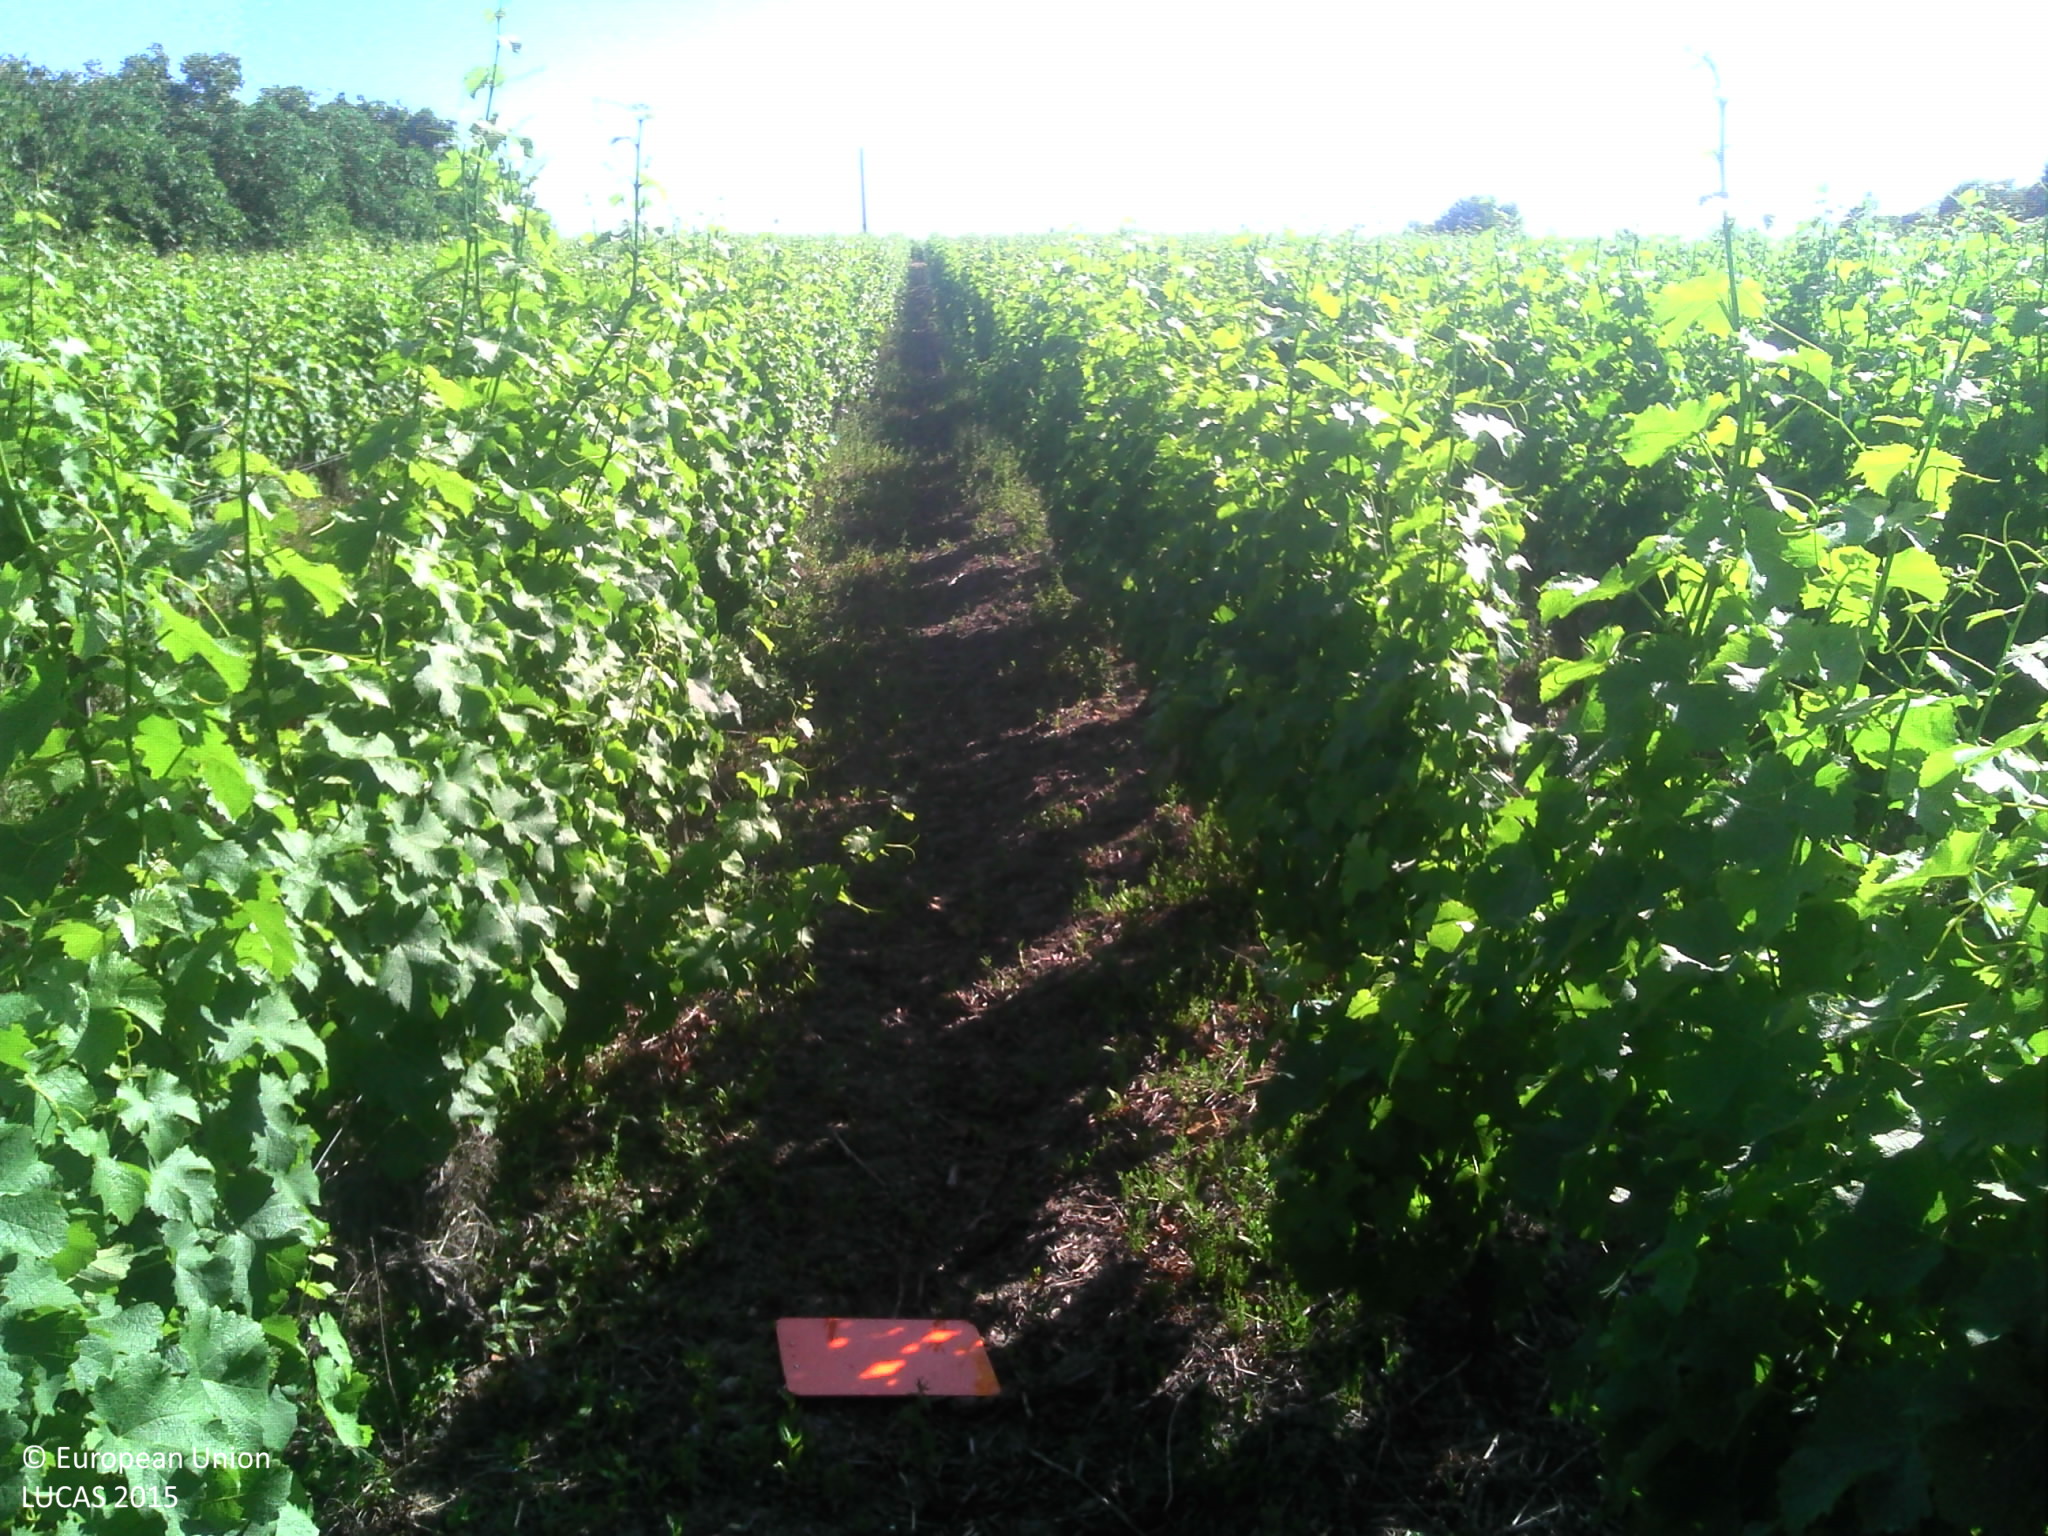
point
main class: Cropland
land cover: Vineyards
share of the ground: 25 - 50 %
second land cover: Other bare soil
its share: > 75 %
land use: Agriculture (excluding fallow land and kitchen gardens)
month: June
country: FR
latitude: 47.2764
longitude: 1.4602
